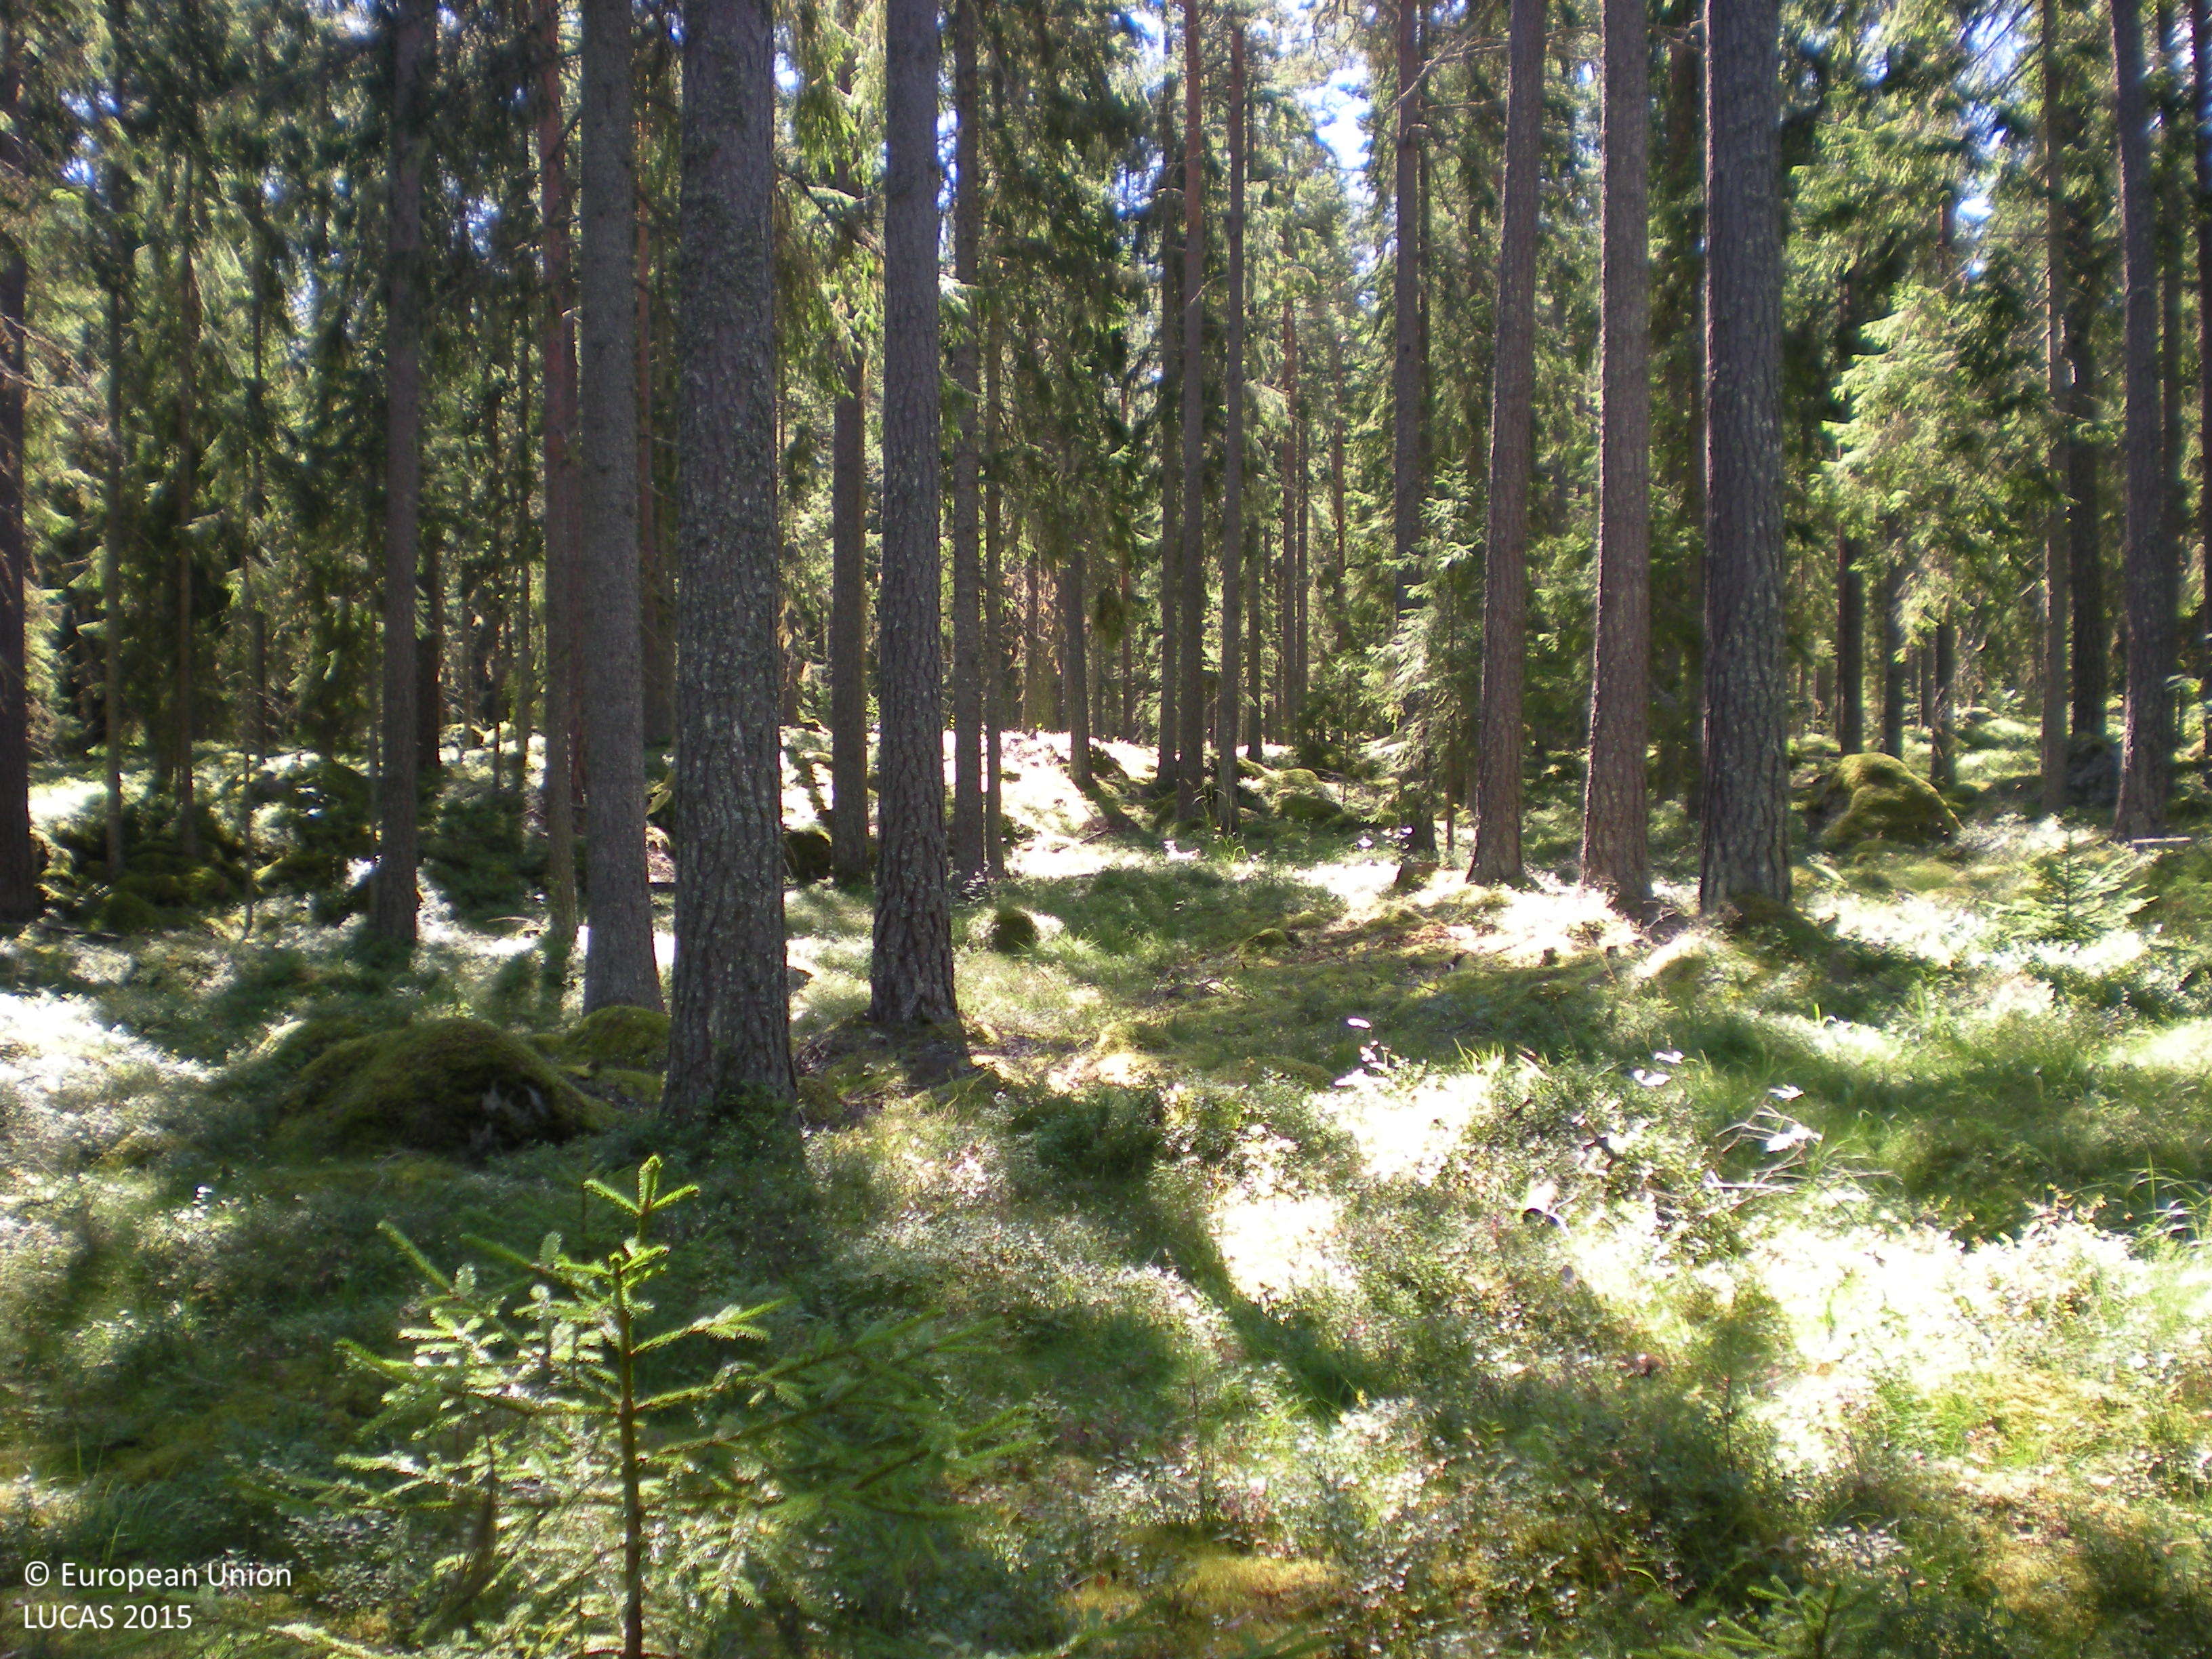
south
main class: Woodland
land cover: Spruce dominated coniferous woodland
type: boreal forest
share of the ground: 50 - 75 %
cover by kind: coniferous forest trees 65 %, shrubs 20 %, herbaceous plants 10 %, lichens and mosses 5 %
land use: Forestry
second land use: Amenities, museums, leisure
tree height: > 5 m
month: August
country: SE
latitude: 60.7064
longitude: 17.1161
